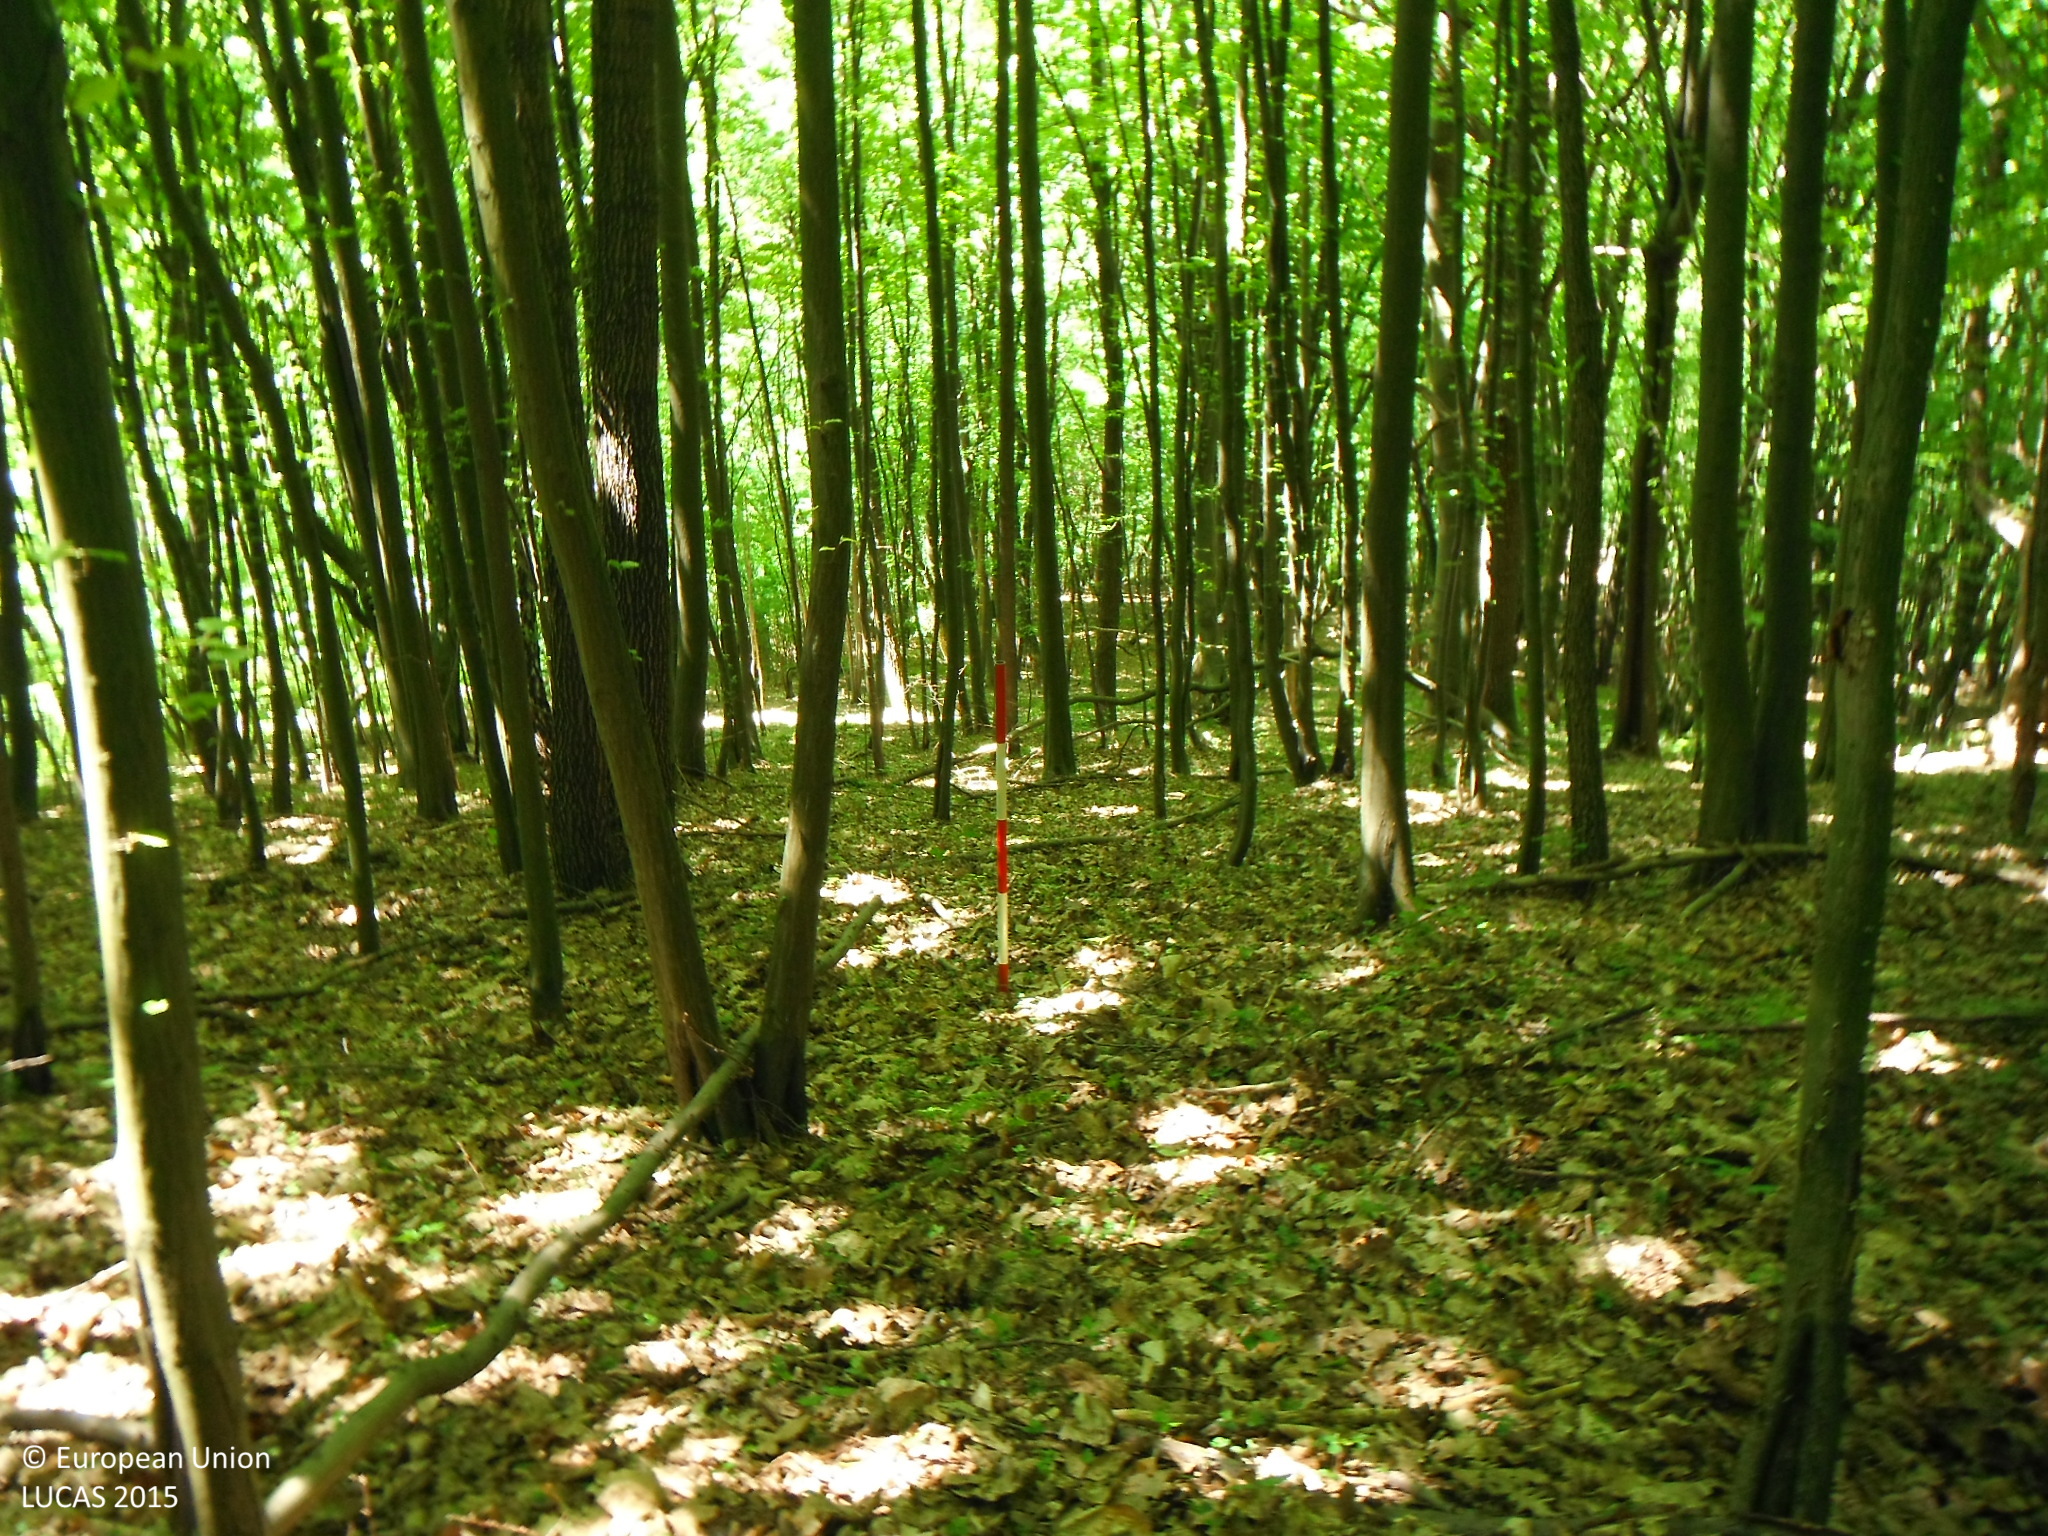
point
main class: Woodland
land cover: Broadleaved woodland
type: mesophytic deciduous forest
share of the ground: > 75 %
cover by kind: broadleaved forest trees 100 %
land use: Forestry
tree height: > 5 m
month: May
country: SK
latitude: 49.1145
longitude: 21.6272
